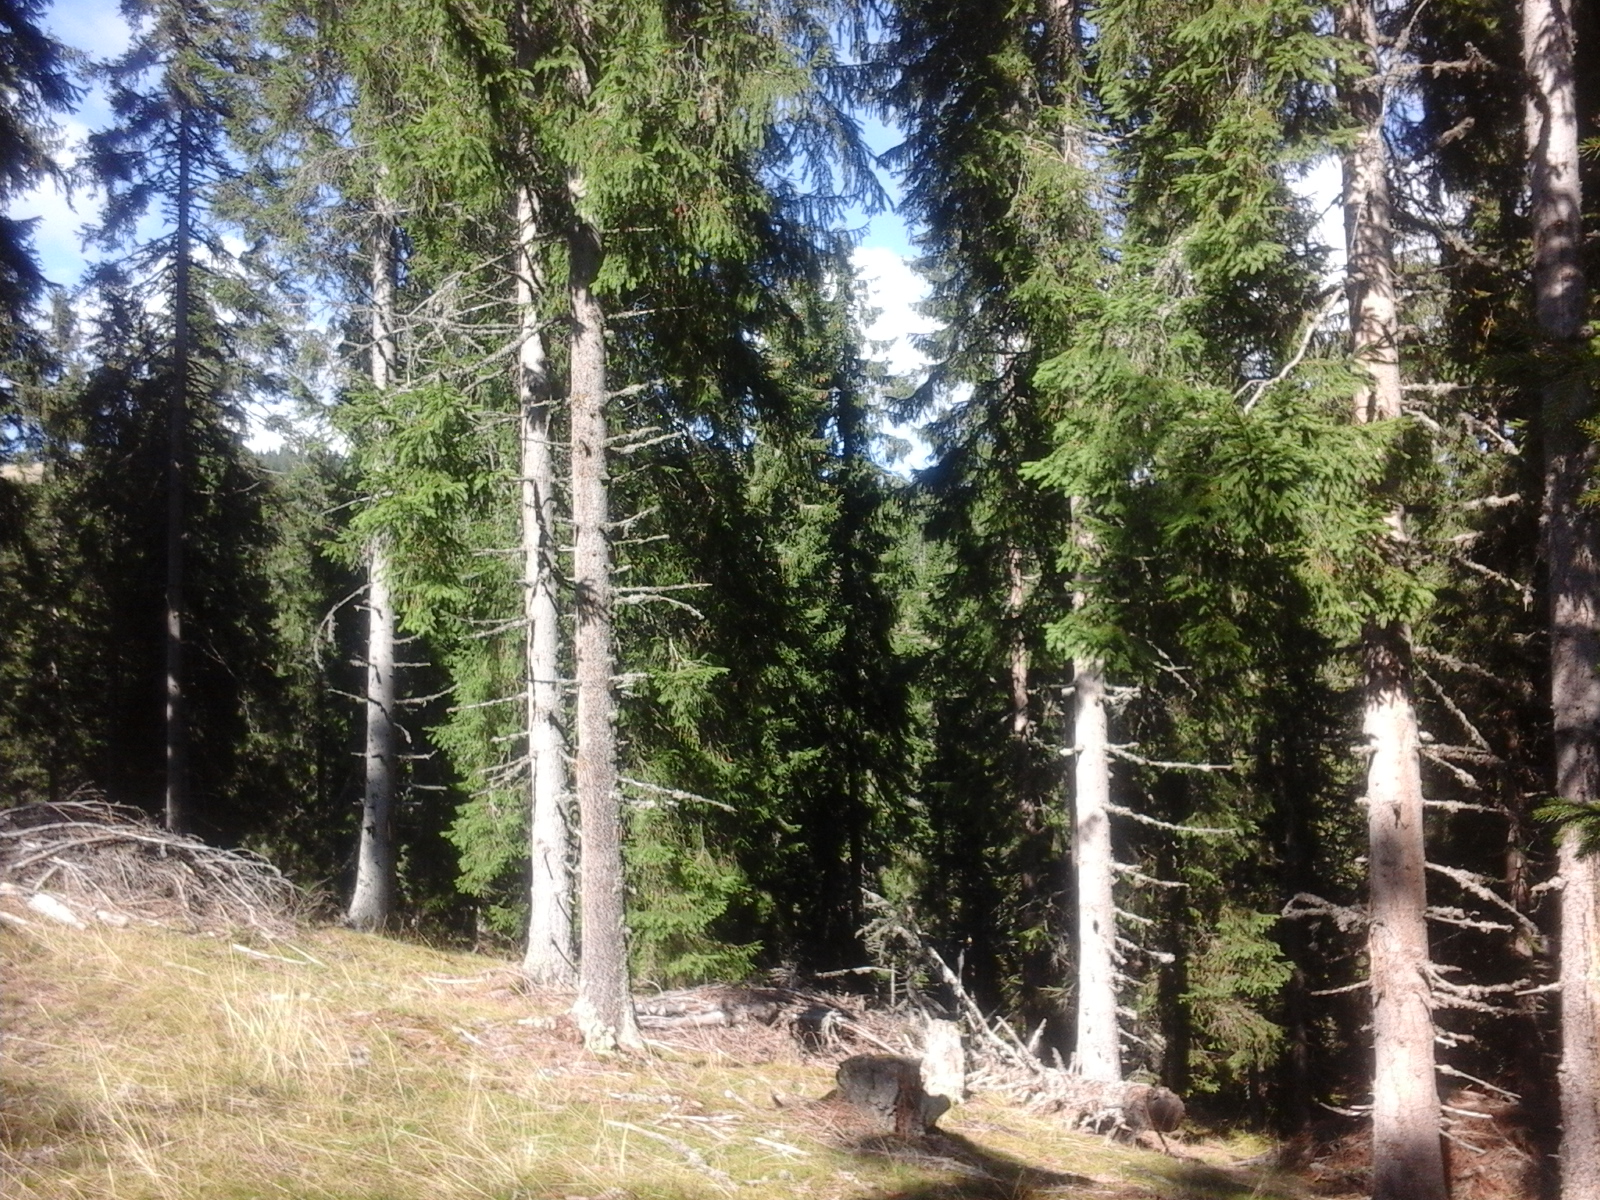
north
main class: Woodland
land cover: Spruce dominated coniferous woodland
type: alpine coniferous forest
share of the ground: > 75 %
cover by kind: coniferous forest trees 100 %
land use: Forestry
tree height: > 5 m
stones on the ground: 25 - 50 %
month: October
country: RO
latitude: 46.5407
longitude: 22.9818
